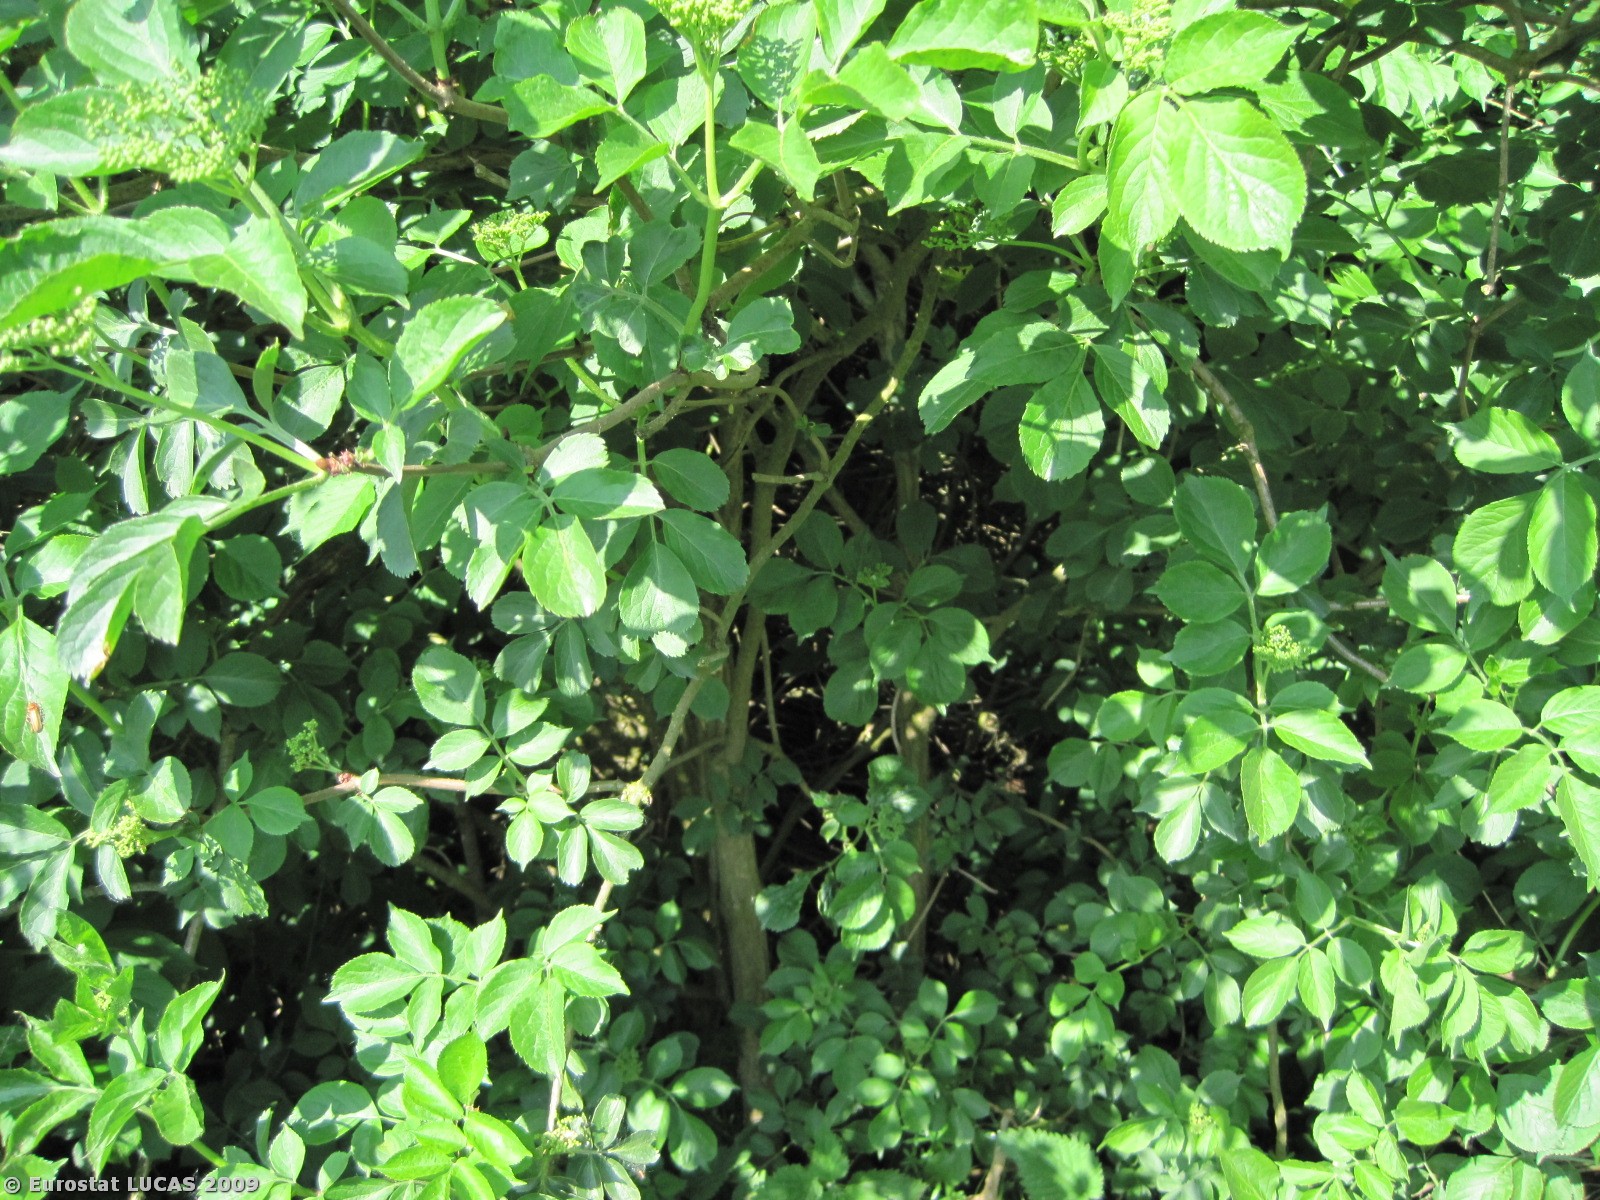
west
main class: Woodland
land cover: Mixed woodland
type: plantations and self-sown exotic forest
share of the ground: > 75 %
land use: Unused
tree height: > 5 m
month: May
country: DK
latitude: 56.5830
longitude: 10.2439
